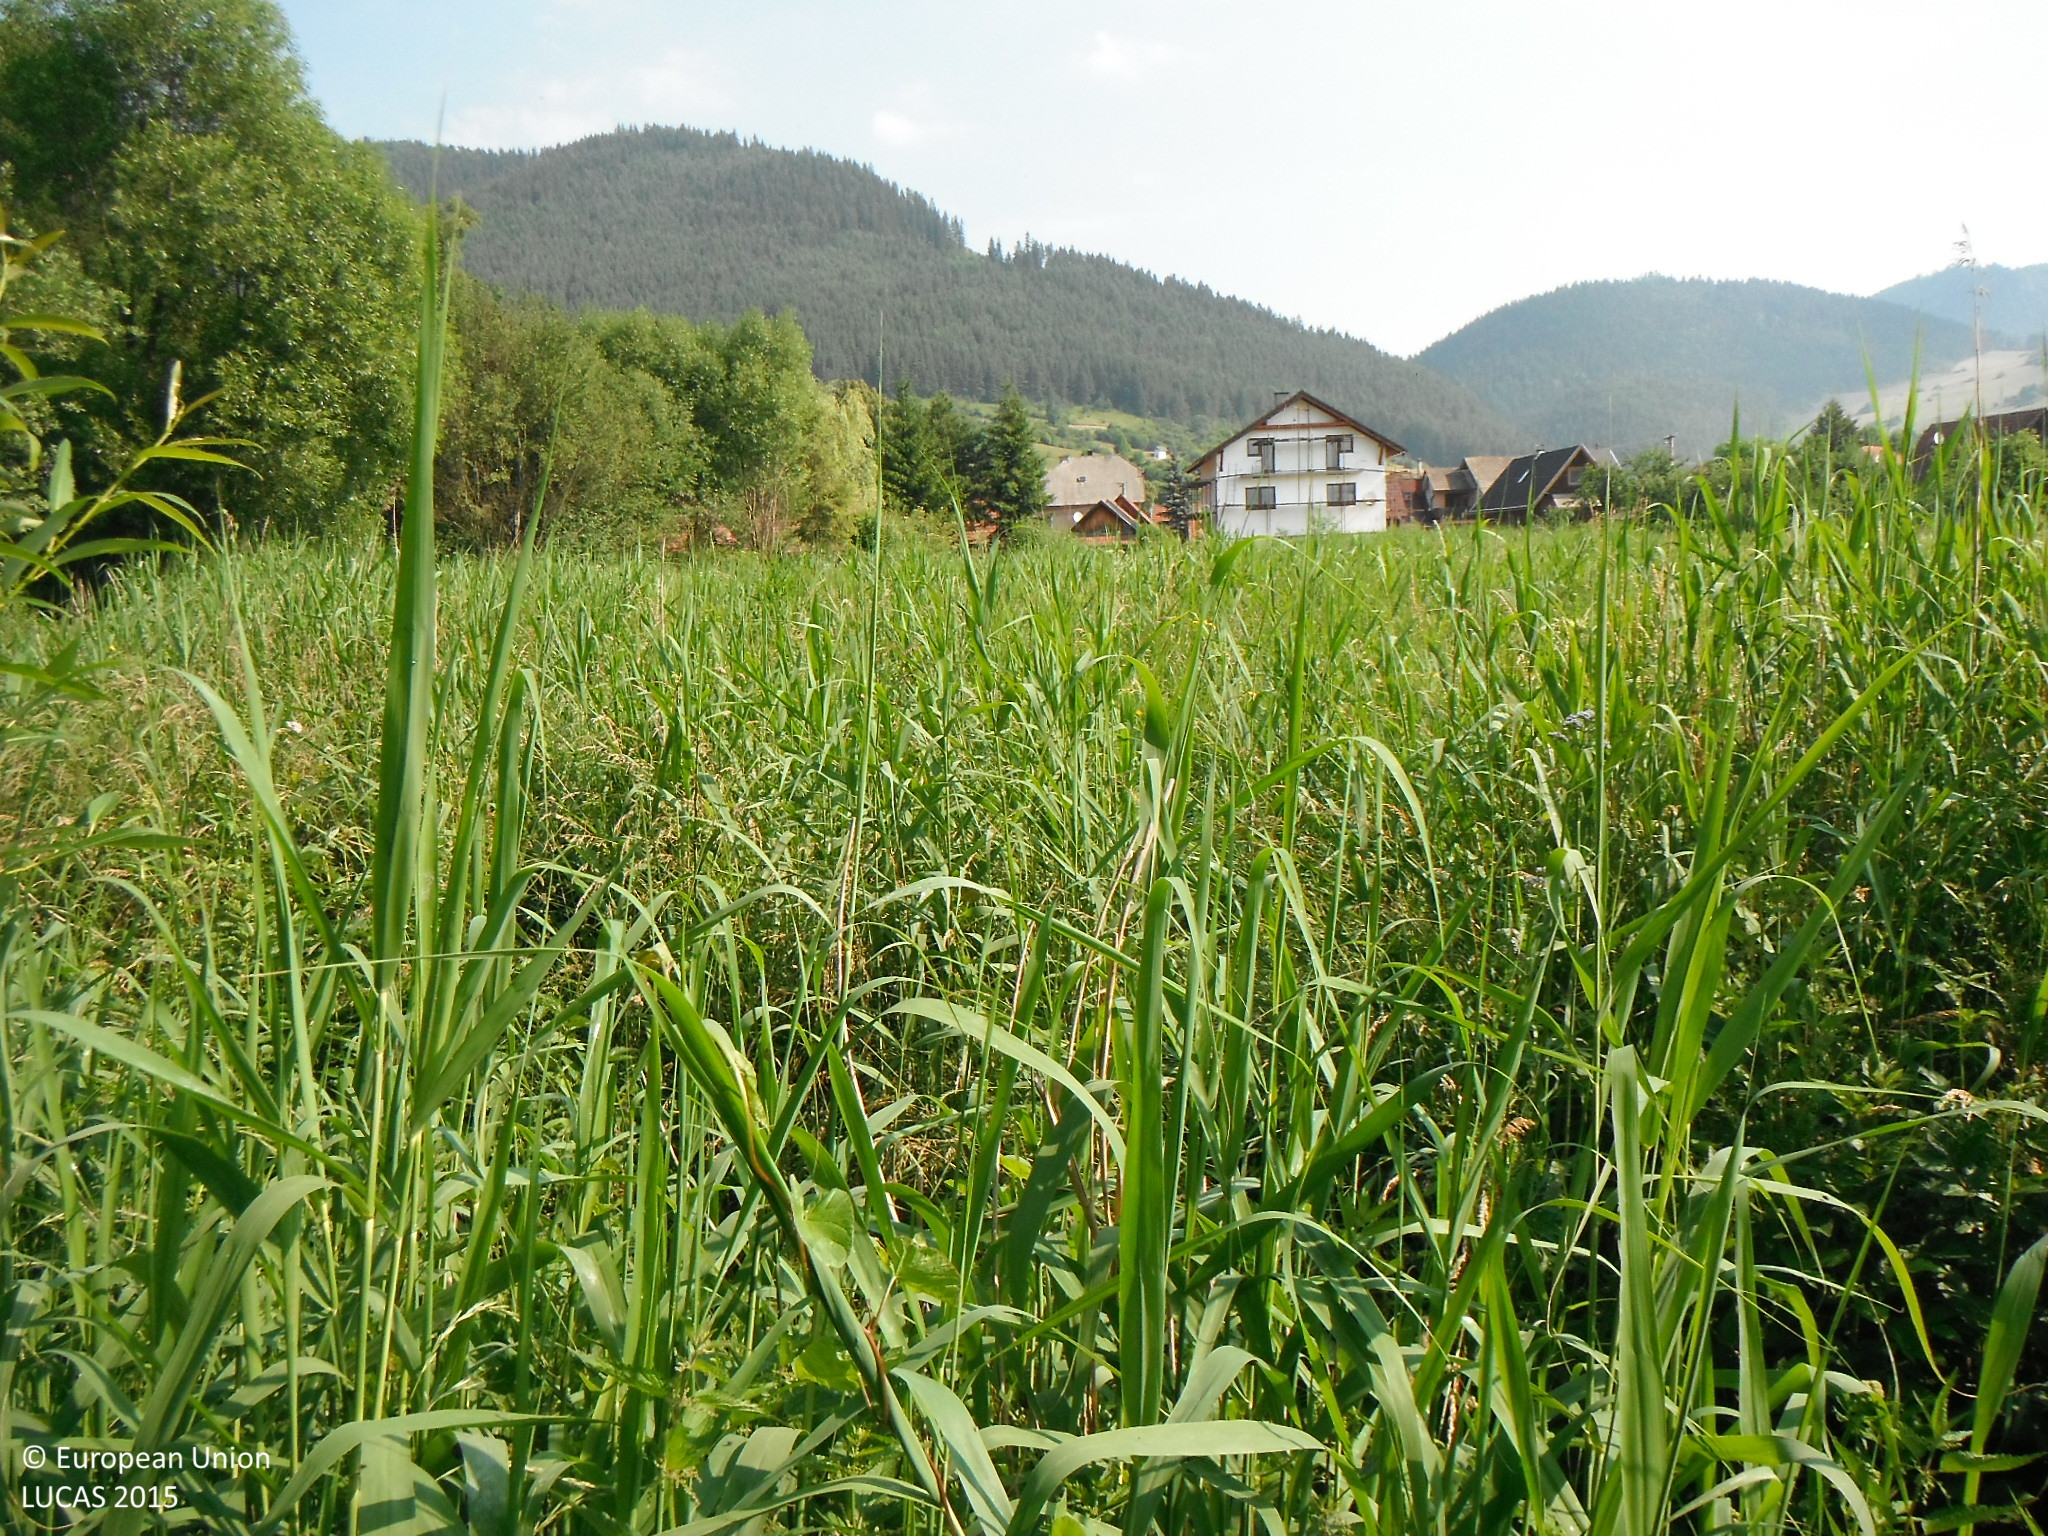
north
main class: Grassland
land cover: Spontaneously vegetated surfaces
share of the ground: > 75 %
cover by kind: herbaceous plants 100 %
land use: Semi-natural and natural areas not in use
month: July
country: SK
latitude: 49.1242
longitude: 19.4119
